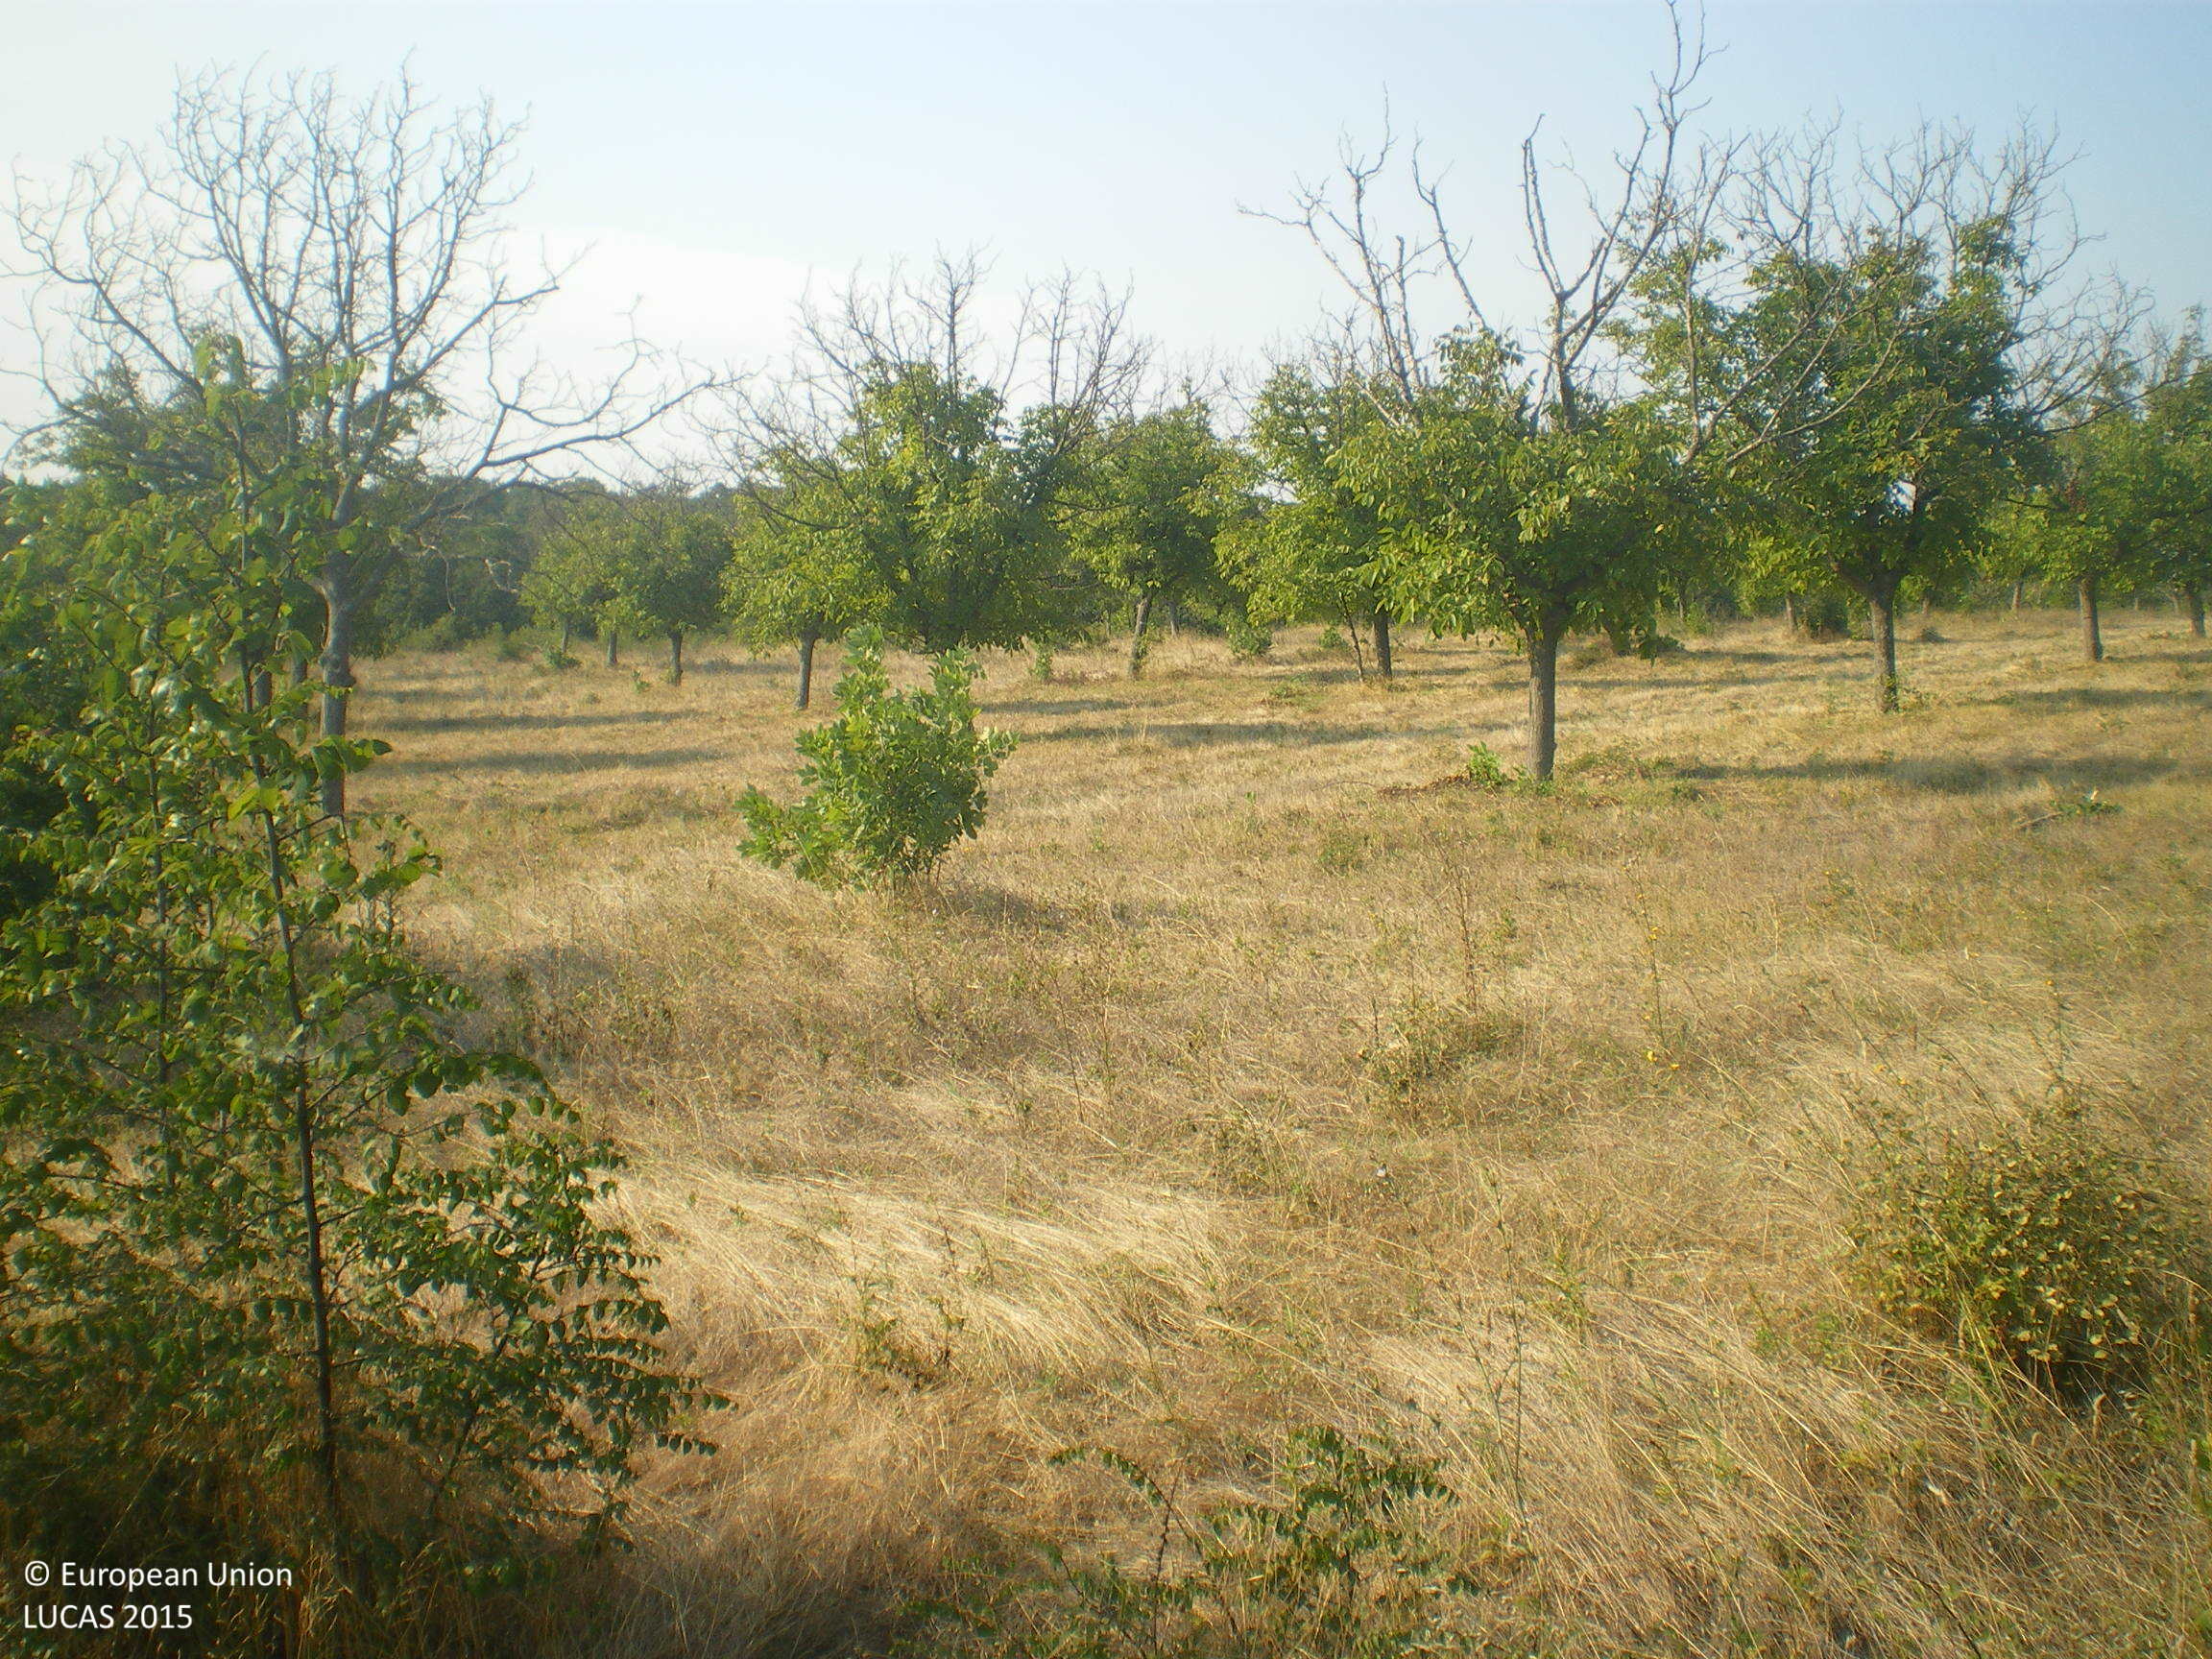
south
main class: Grassland
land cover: Grassland with sparse tree/shrub cover
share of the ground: > 75 %
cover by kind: herbaceous plants 85 %, shrubs 10 %, broadleaved forest trees 5 %
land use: Agriculture (excluding fallow land and kitchen gardens)
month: August
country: BG
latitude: 41.9851
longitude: 25.8464
